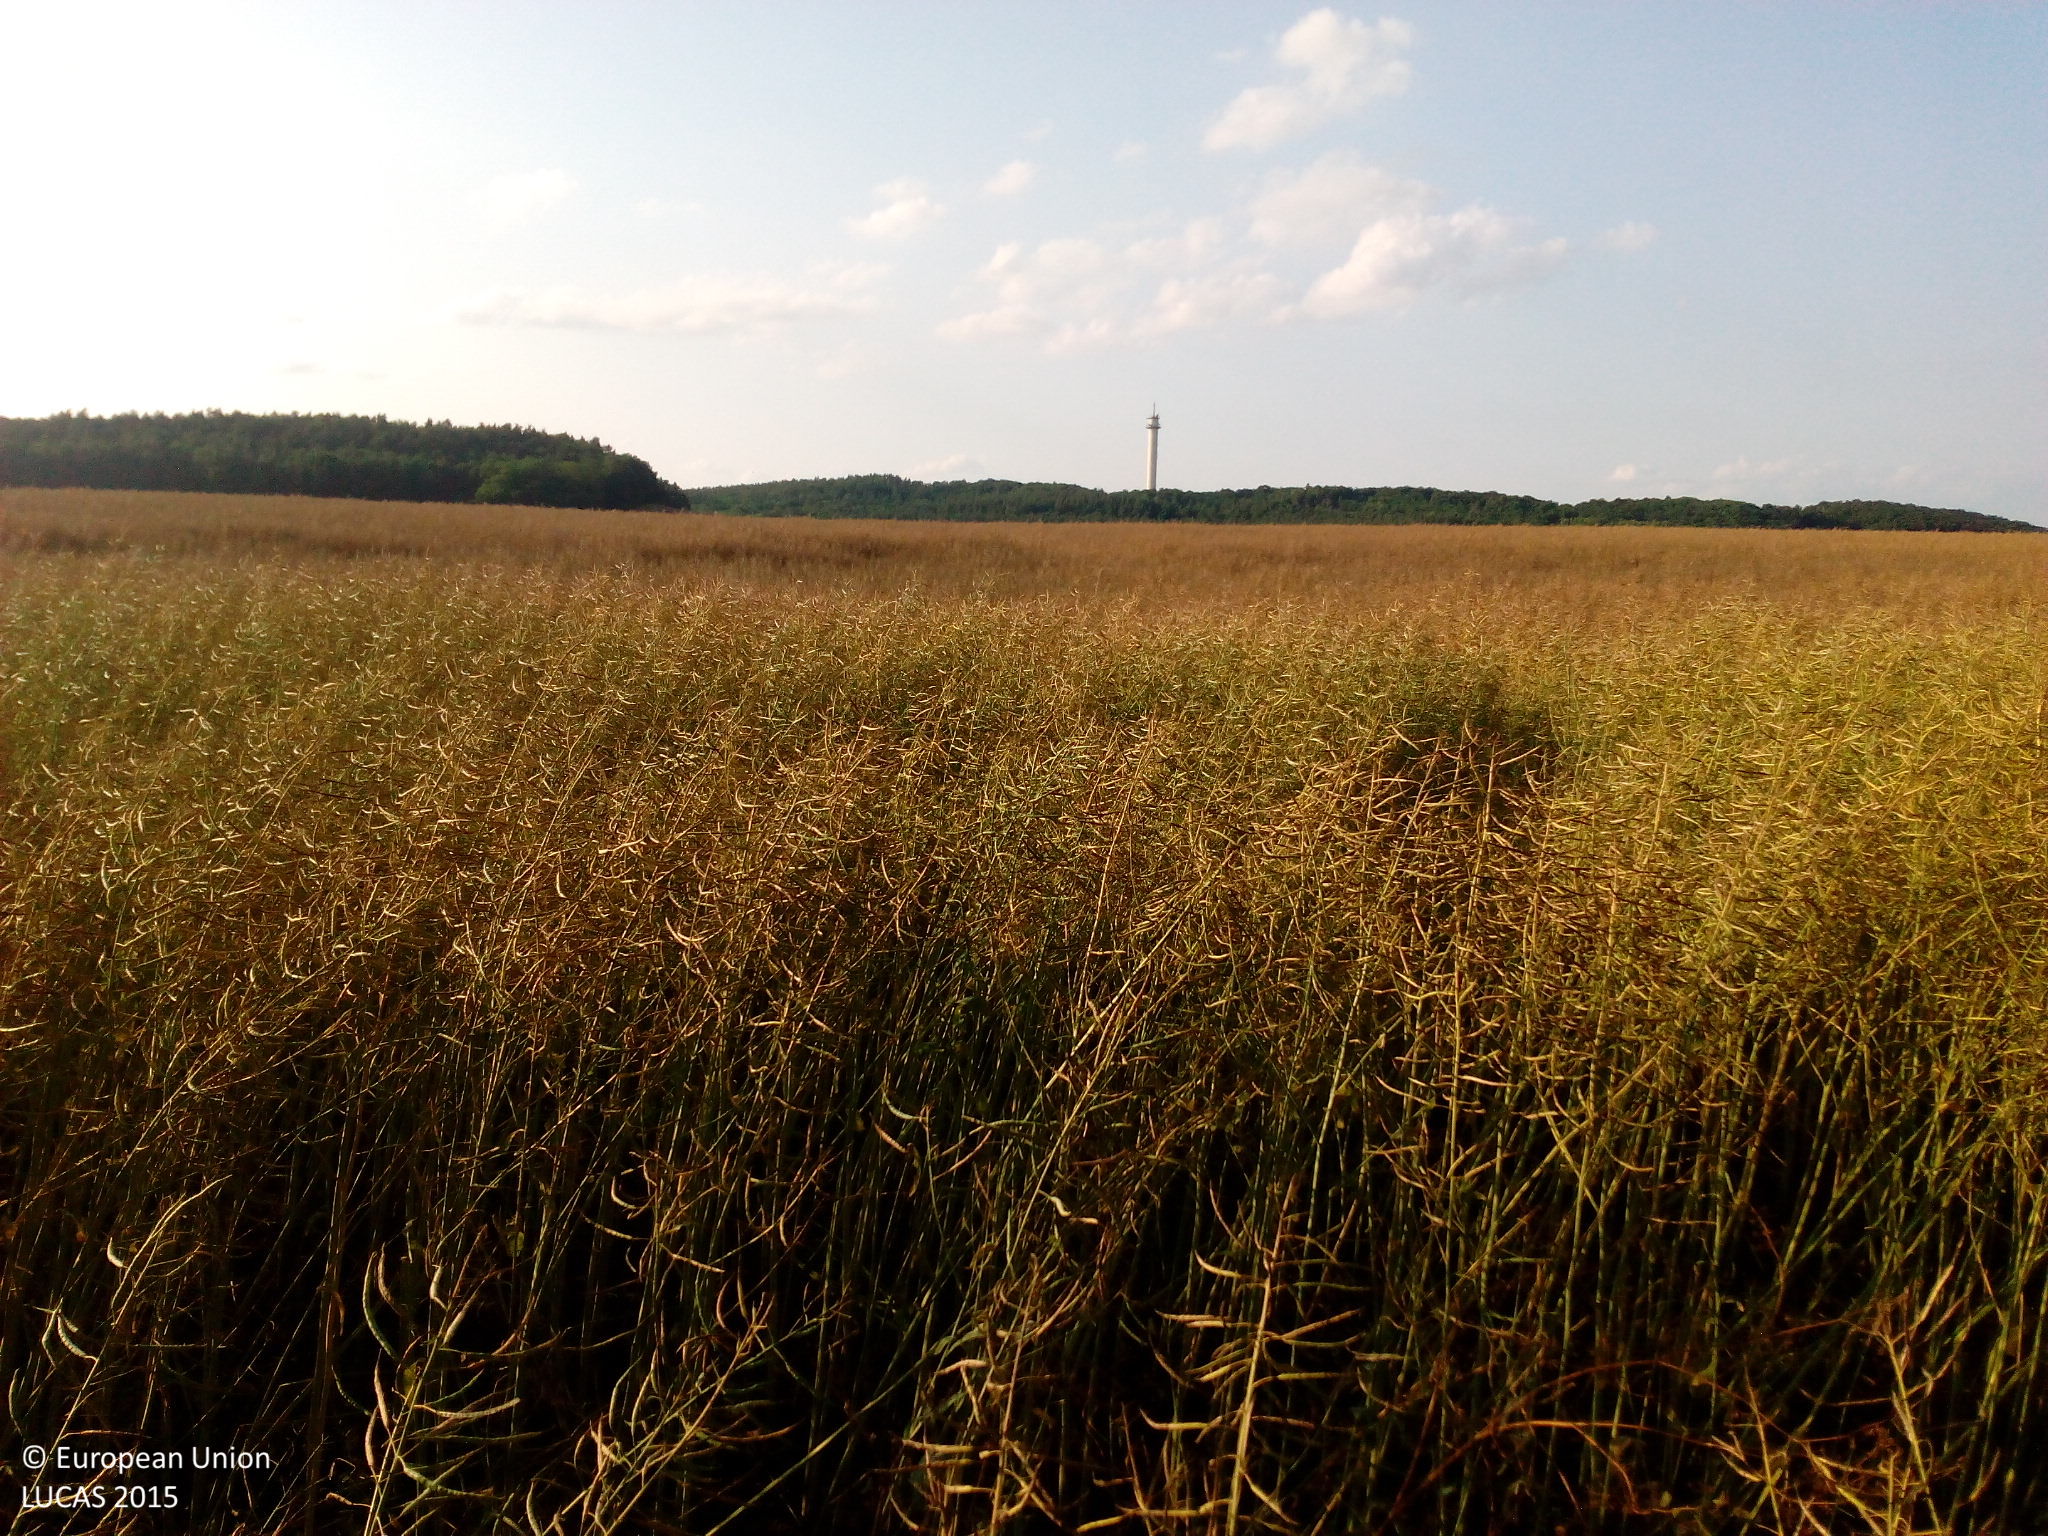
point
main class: Cropland
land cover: Rape and turnip rape
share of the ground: > 75 %
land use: Agriculture (excluding fallow land and kitchen gardens)
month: July
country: DE
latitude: 52.7318
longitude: 12.3541
